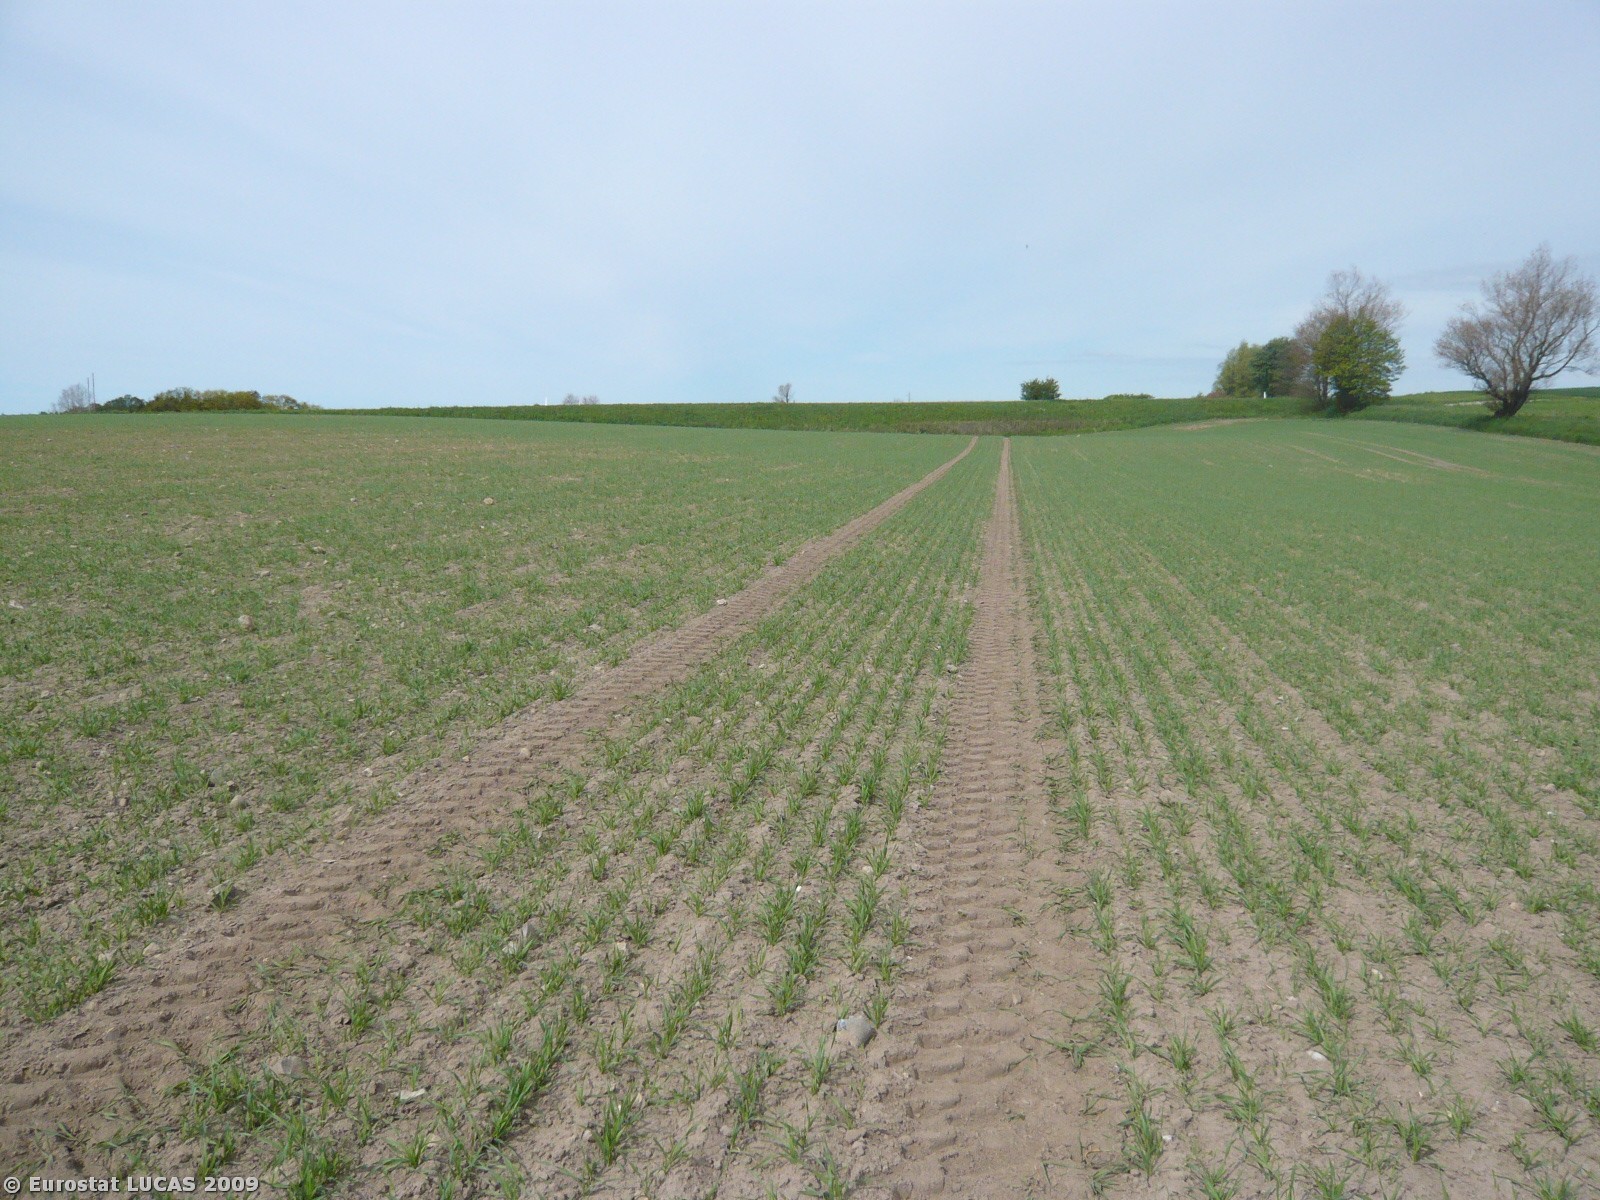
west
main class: Cropland
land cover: Common wheat
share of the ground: 25 - 50 %
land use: Agriculture (excluding fallow land and kitchen gardens)
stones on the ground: 10 - 25 %
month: May
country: DK
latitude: 55.1489
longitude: 11.8973
